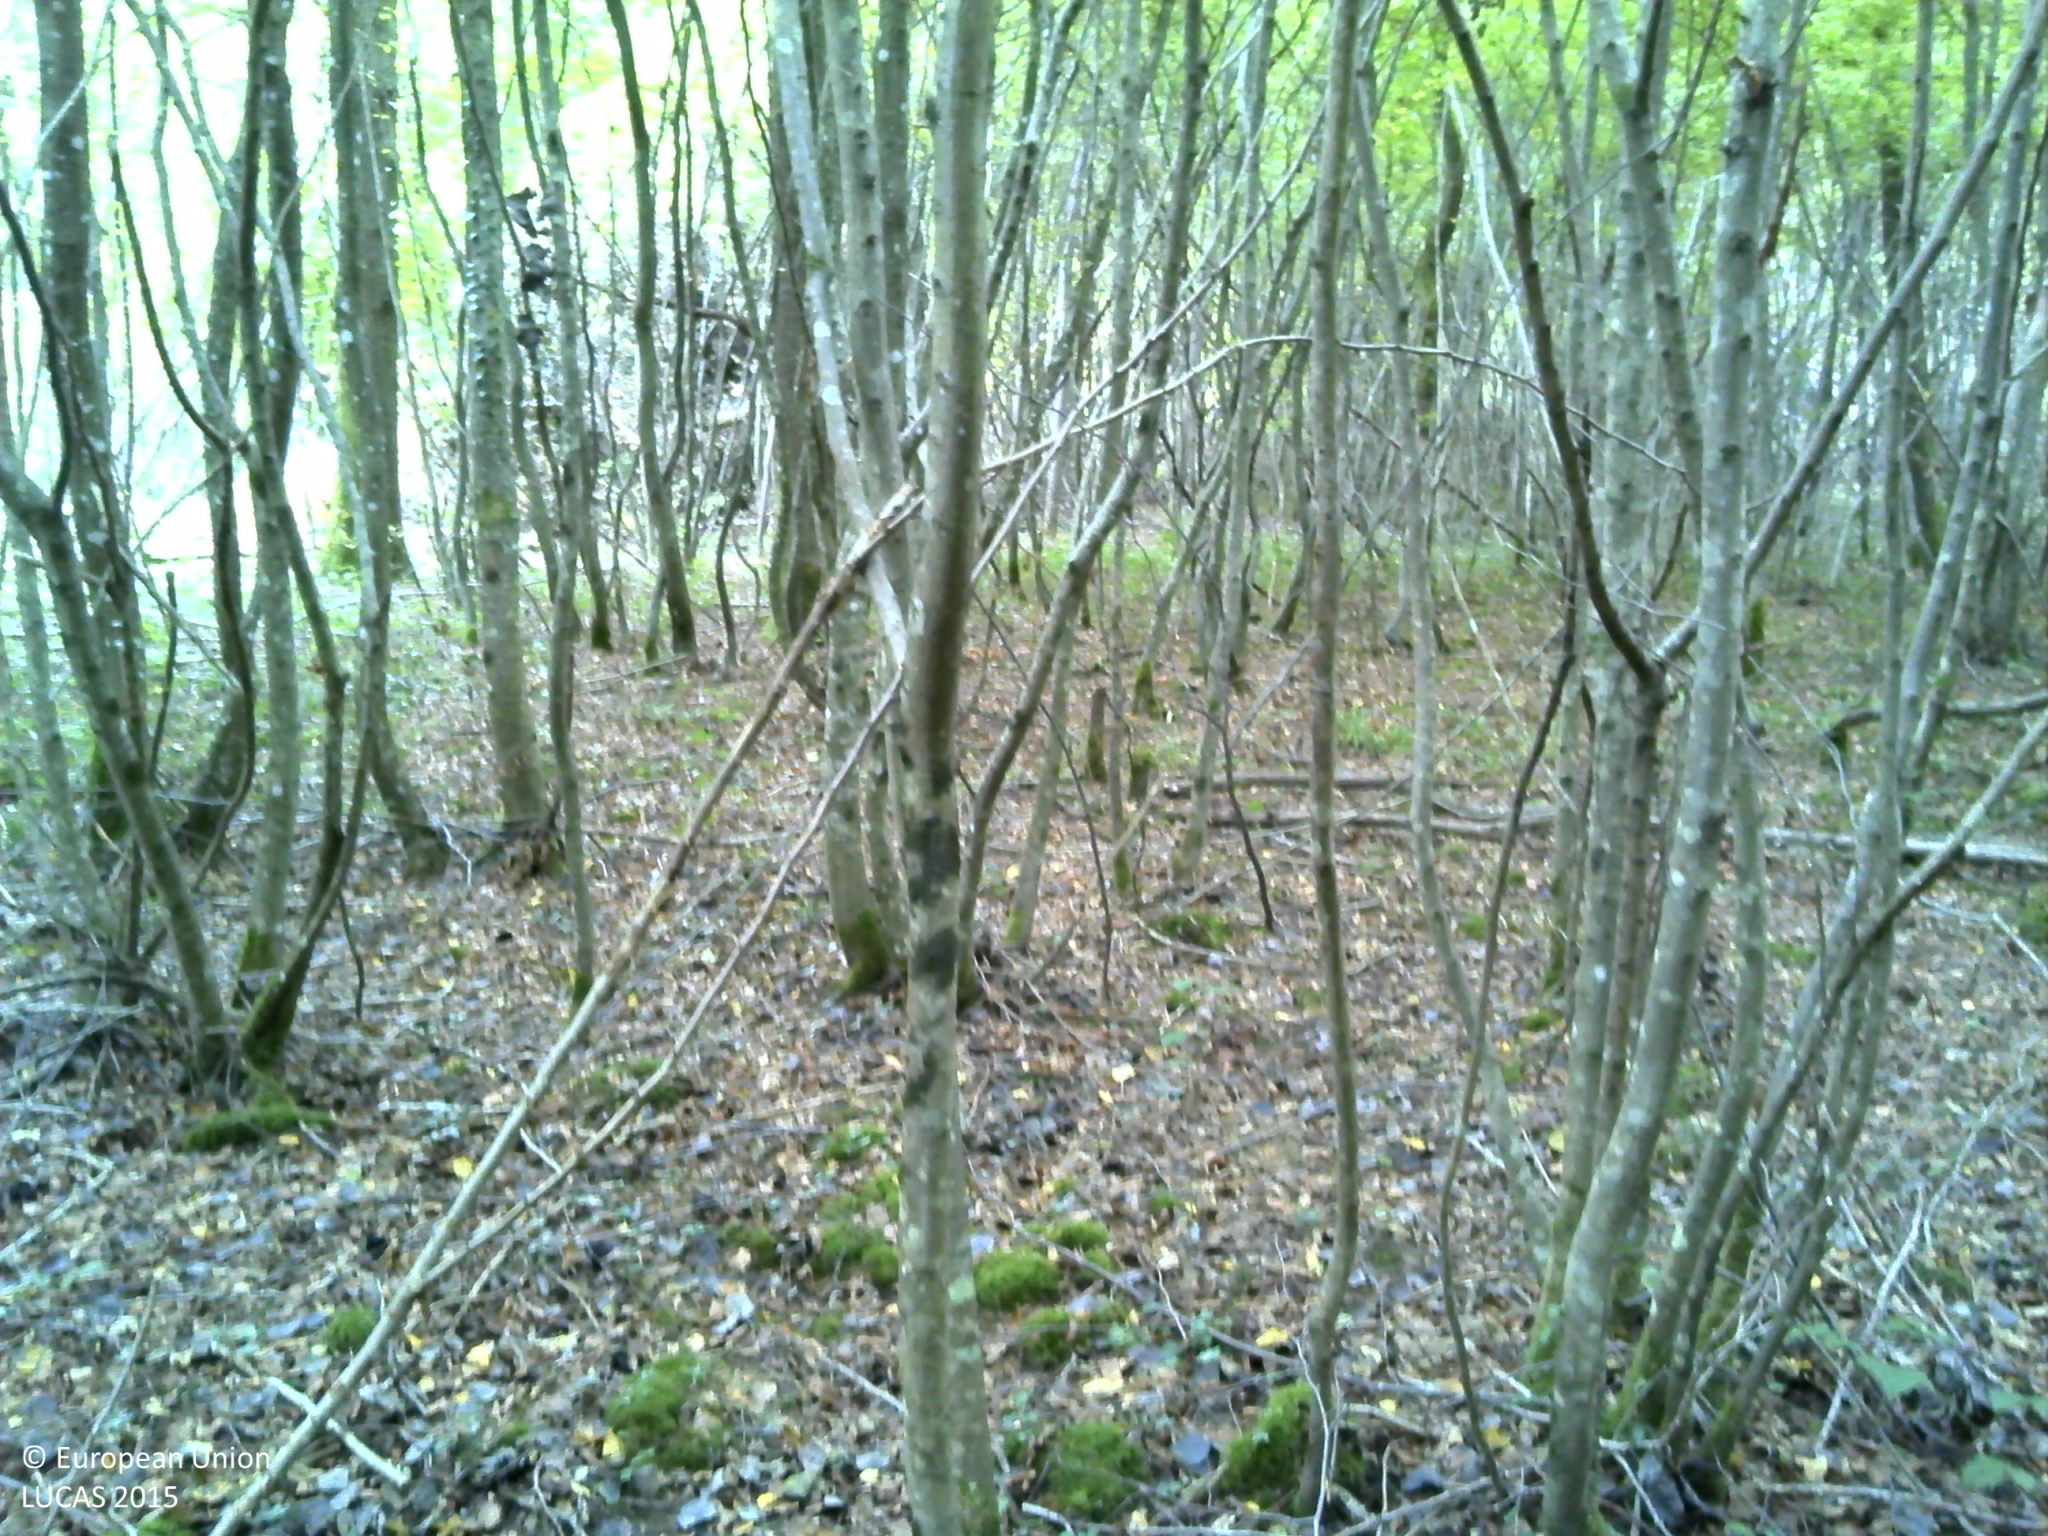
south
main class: Woodland
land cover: Broadleaved woodland
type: non-riverine alder, birch or aspen forest
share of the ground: > 75 %
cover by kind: broadleaved forest trees 85 %, herbaceous plants 10 %
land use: Forestry
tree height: > 5 m
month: October
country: FR
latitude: 46.8945
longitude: 4.8428
